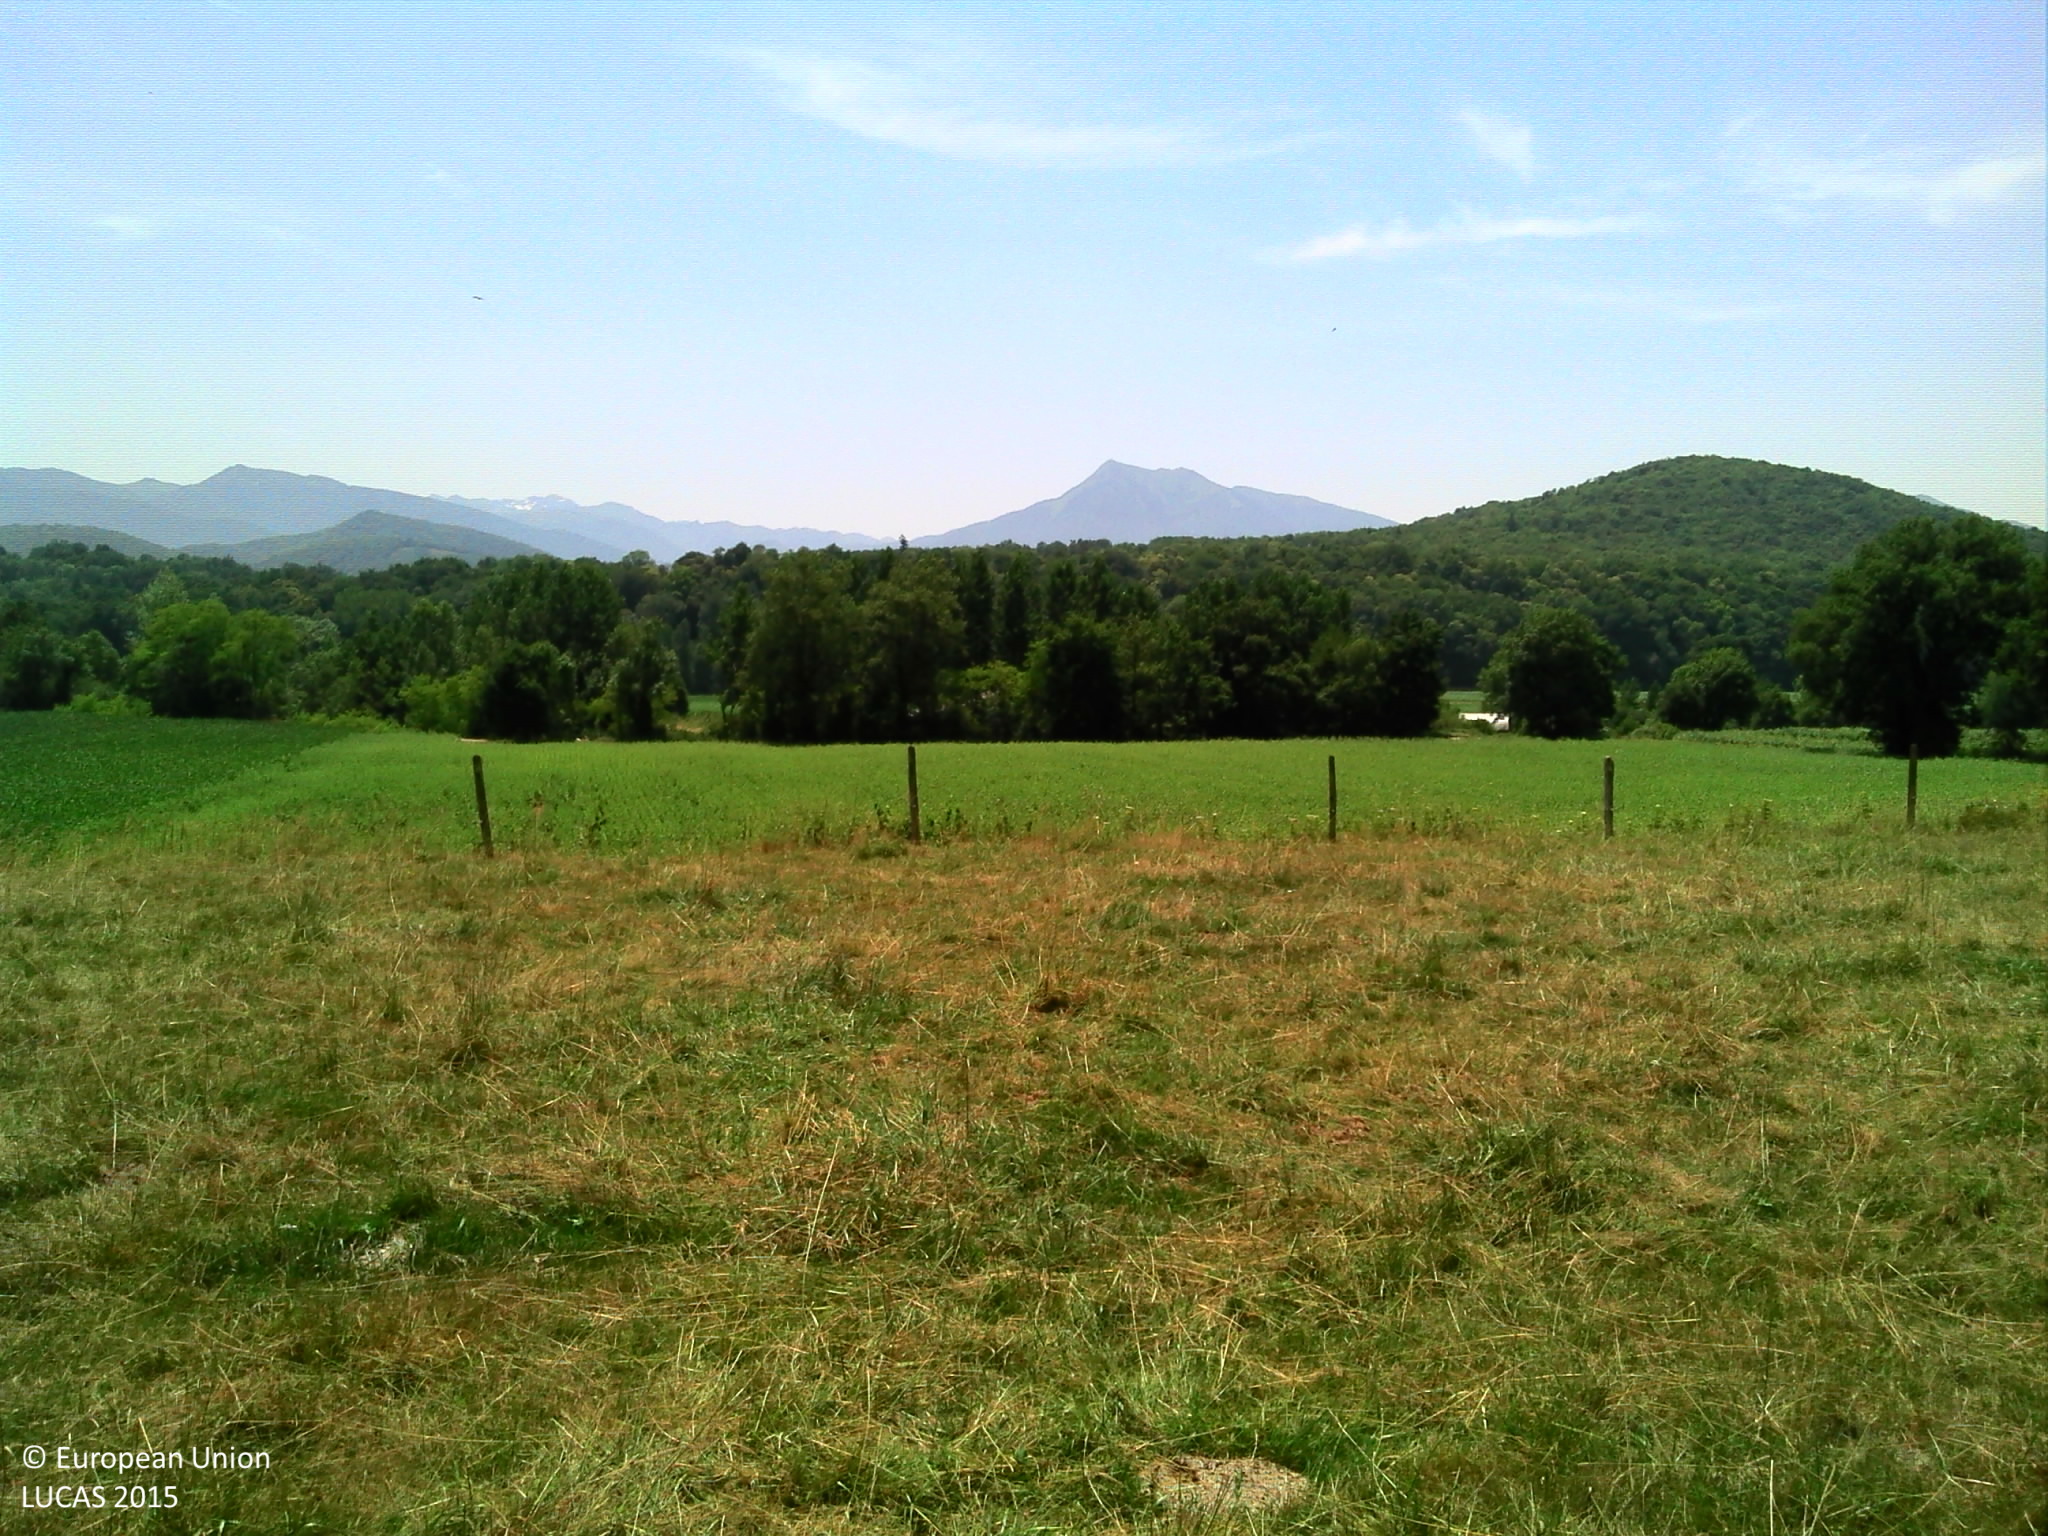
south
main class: Grassland
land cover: Grassland without tree/shrub cover
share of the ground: > 75 %
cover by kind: herbaceous plants 100 %
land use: Agriculture (excluding fallow land and kitchen gardens)
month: July
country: FR
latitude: 43.0860
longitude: 0.7771
